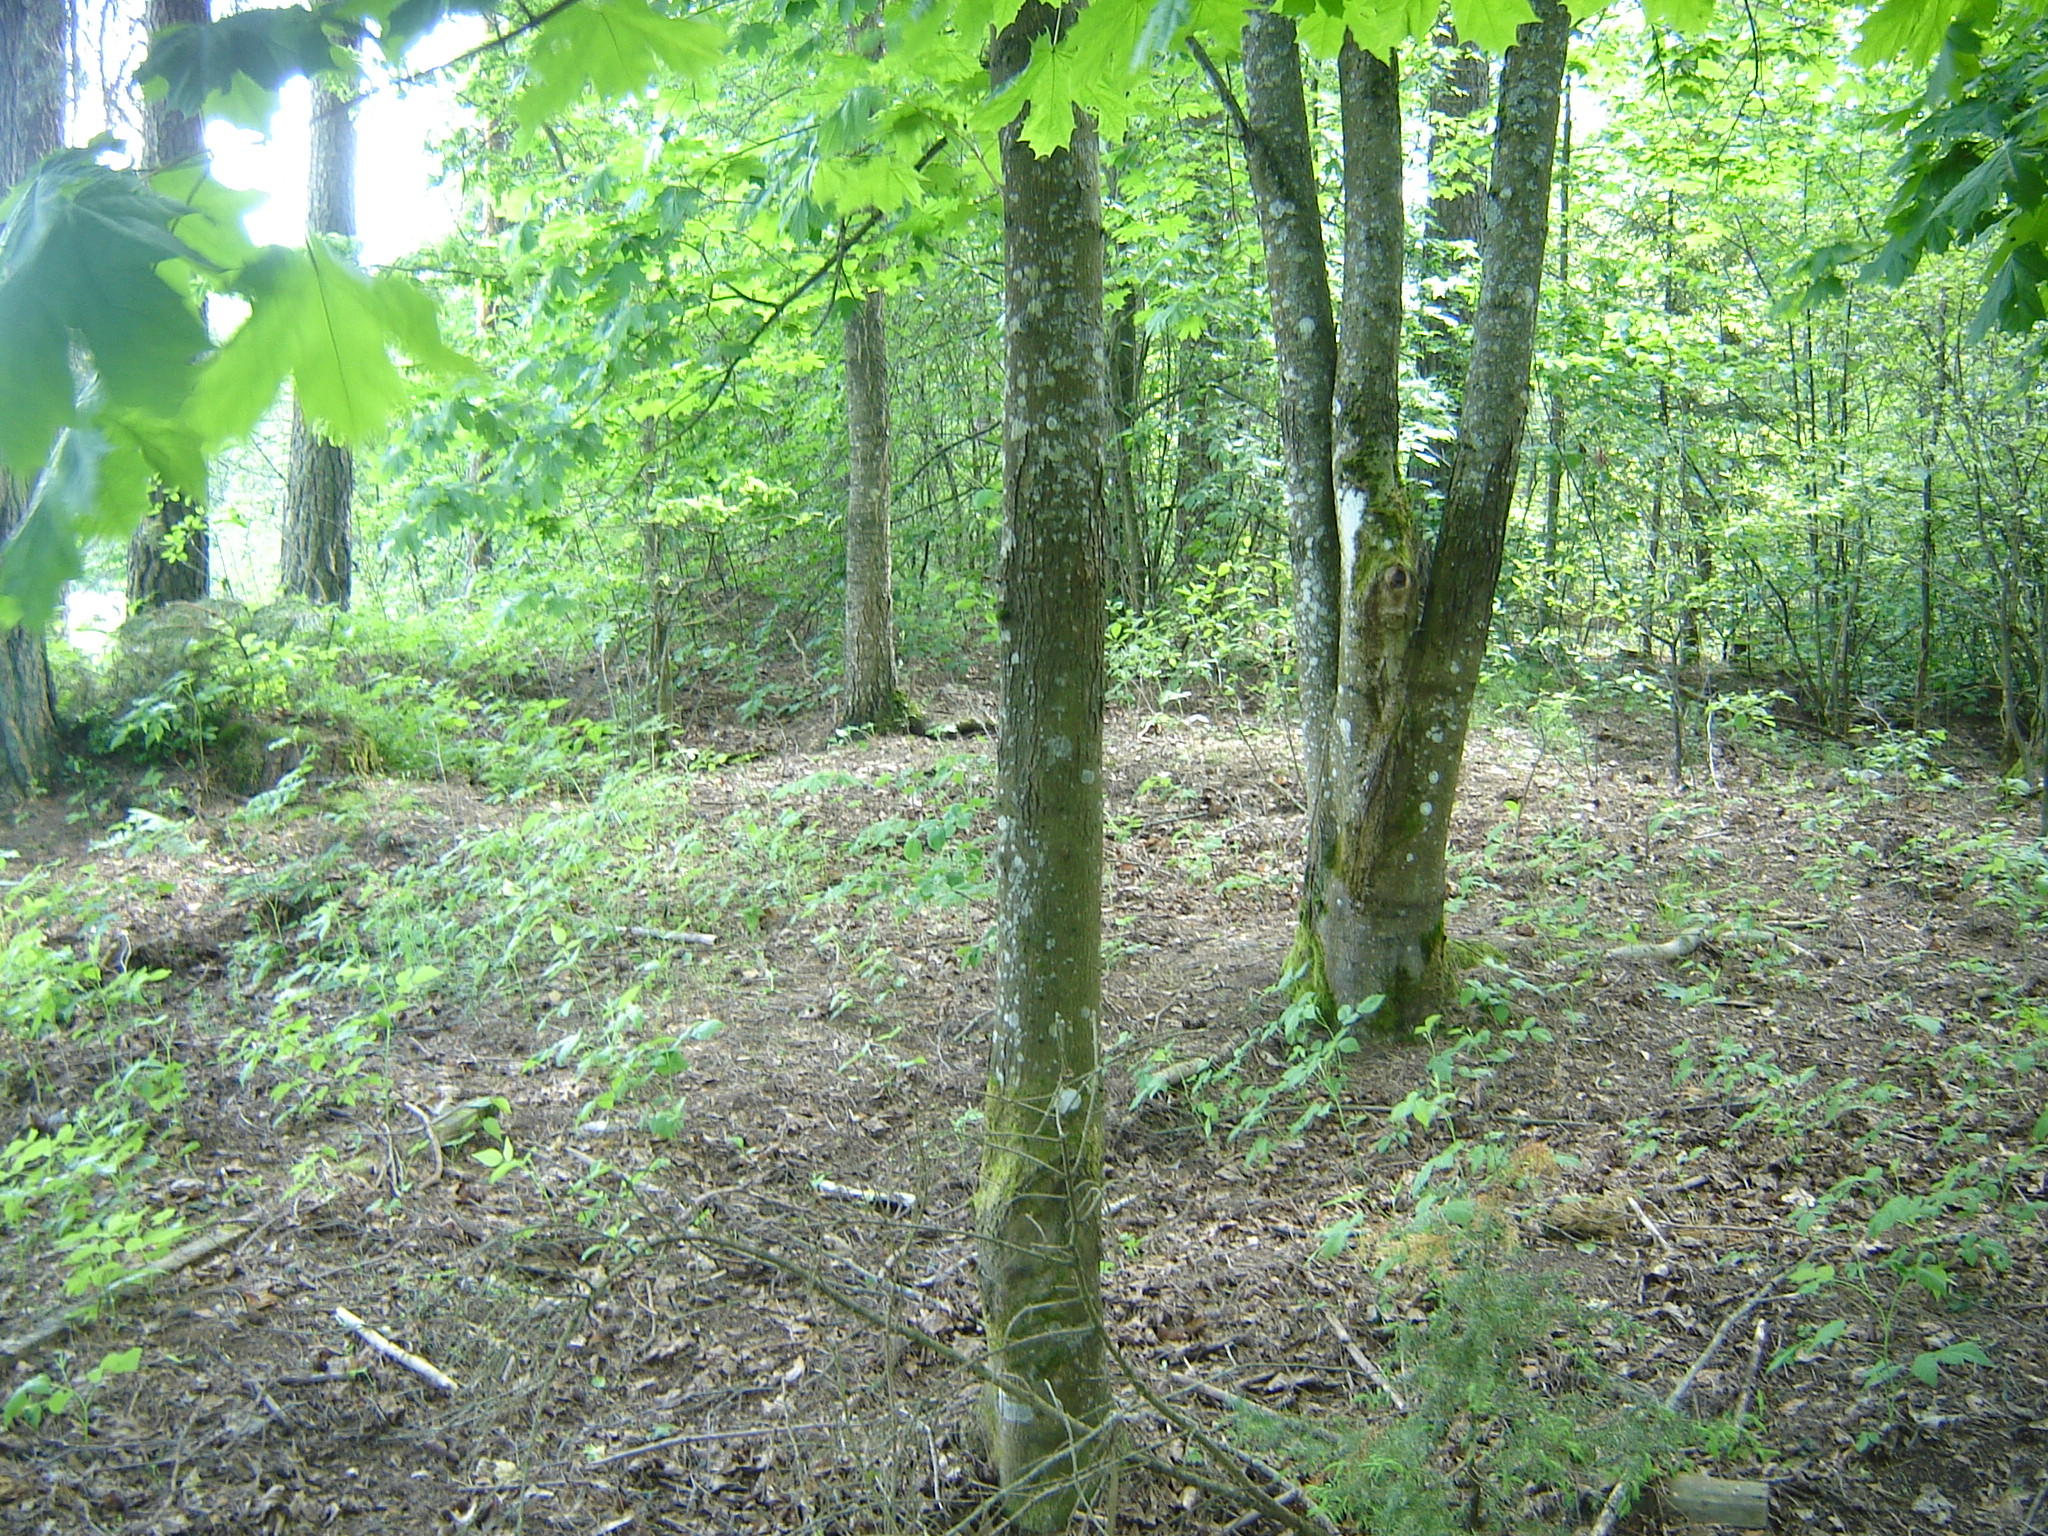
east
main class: Woodland
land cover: Other mixed woodland
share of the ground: > 75 %
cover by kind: coniferous forest trees 55 %, broadleaved forest trees 30 %, unconsolidated bare surface 10 %, herbaceous plants 5 %
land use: Forestry
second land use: Residential
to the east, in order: Other mixed woodland; Pine dominated coniferous woodland; Grassland without tree/shrub cover; Spontaneously vegetated surfaces; Inland fresh running water; Spontaneously vegetated surfaces; Broadleaved woodland; Pine dominated mixed woodland
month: May
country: LT
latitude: 55.7181
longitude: 25.3215
